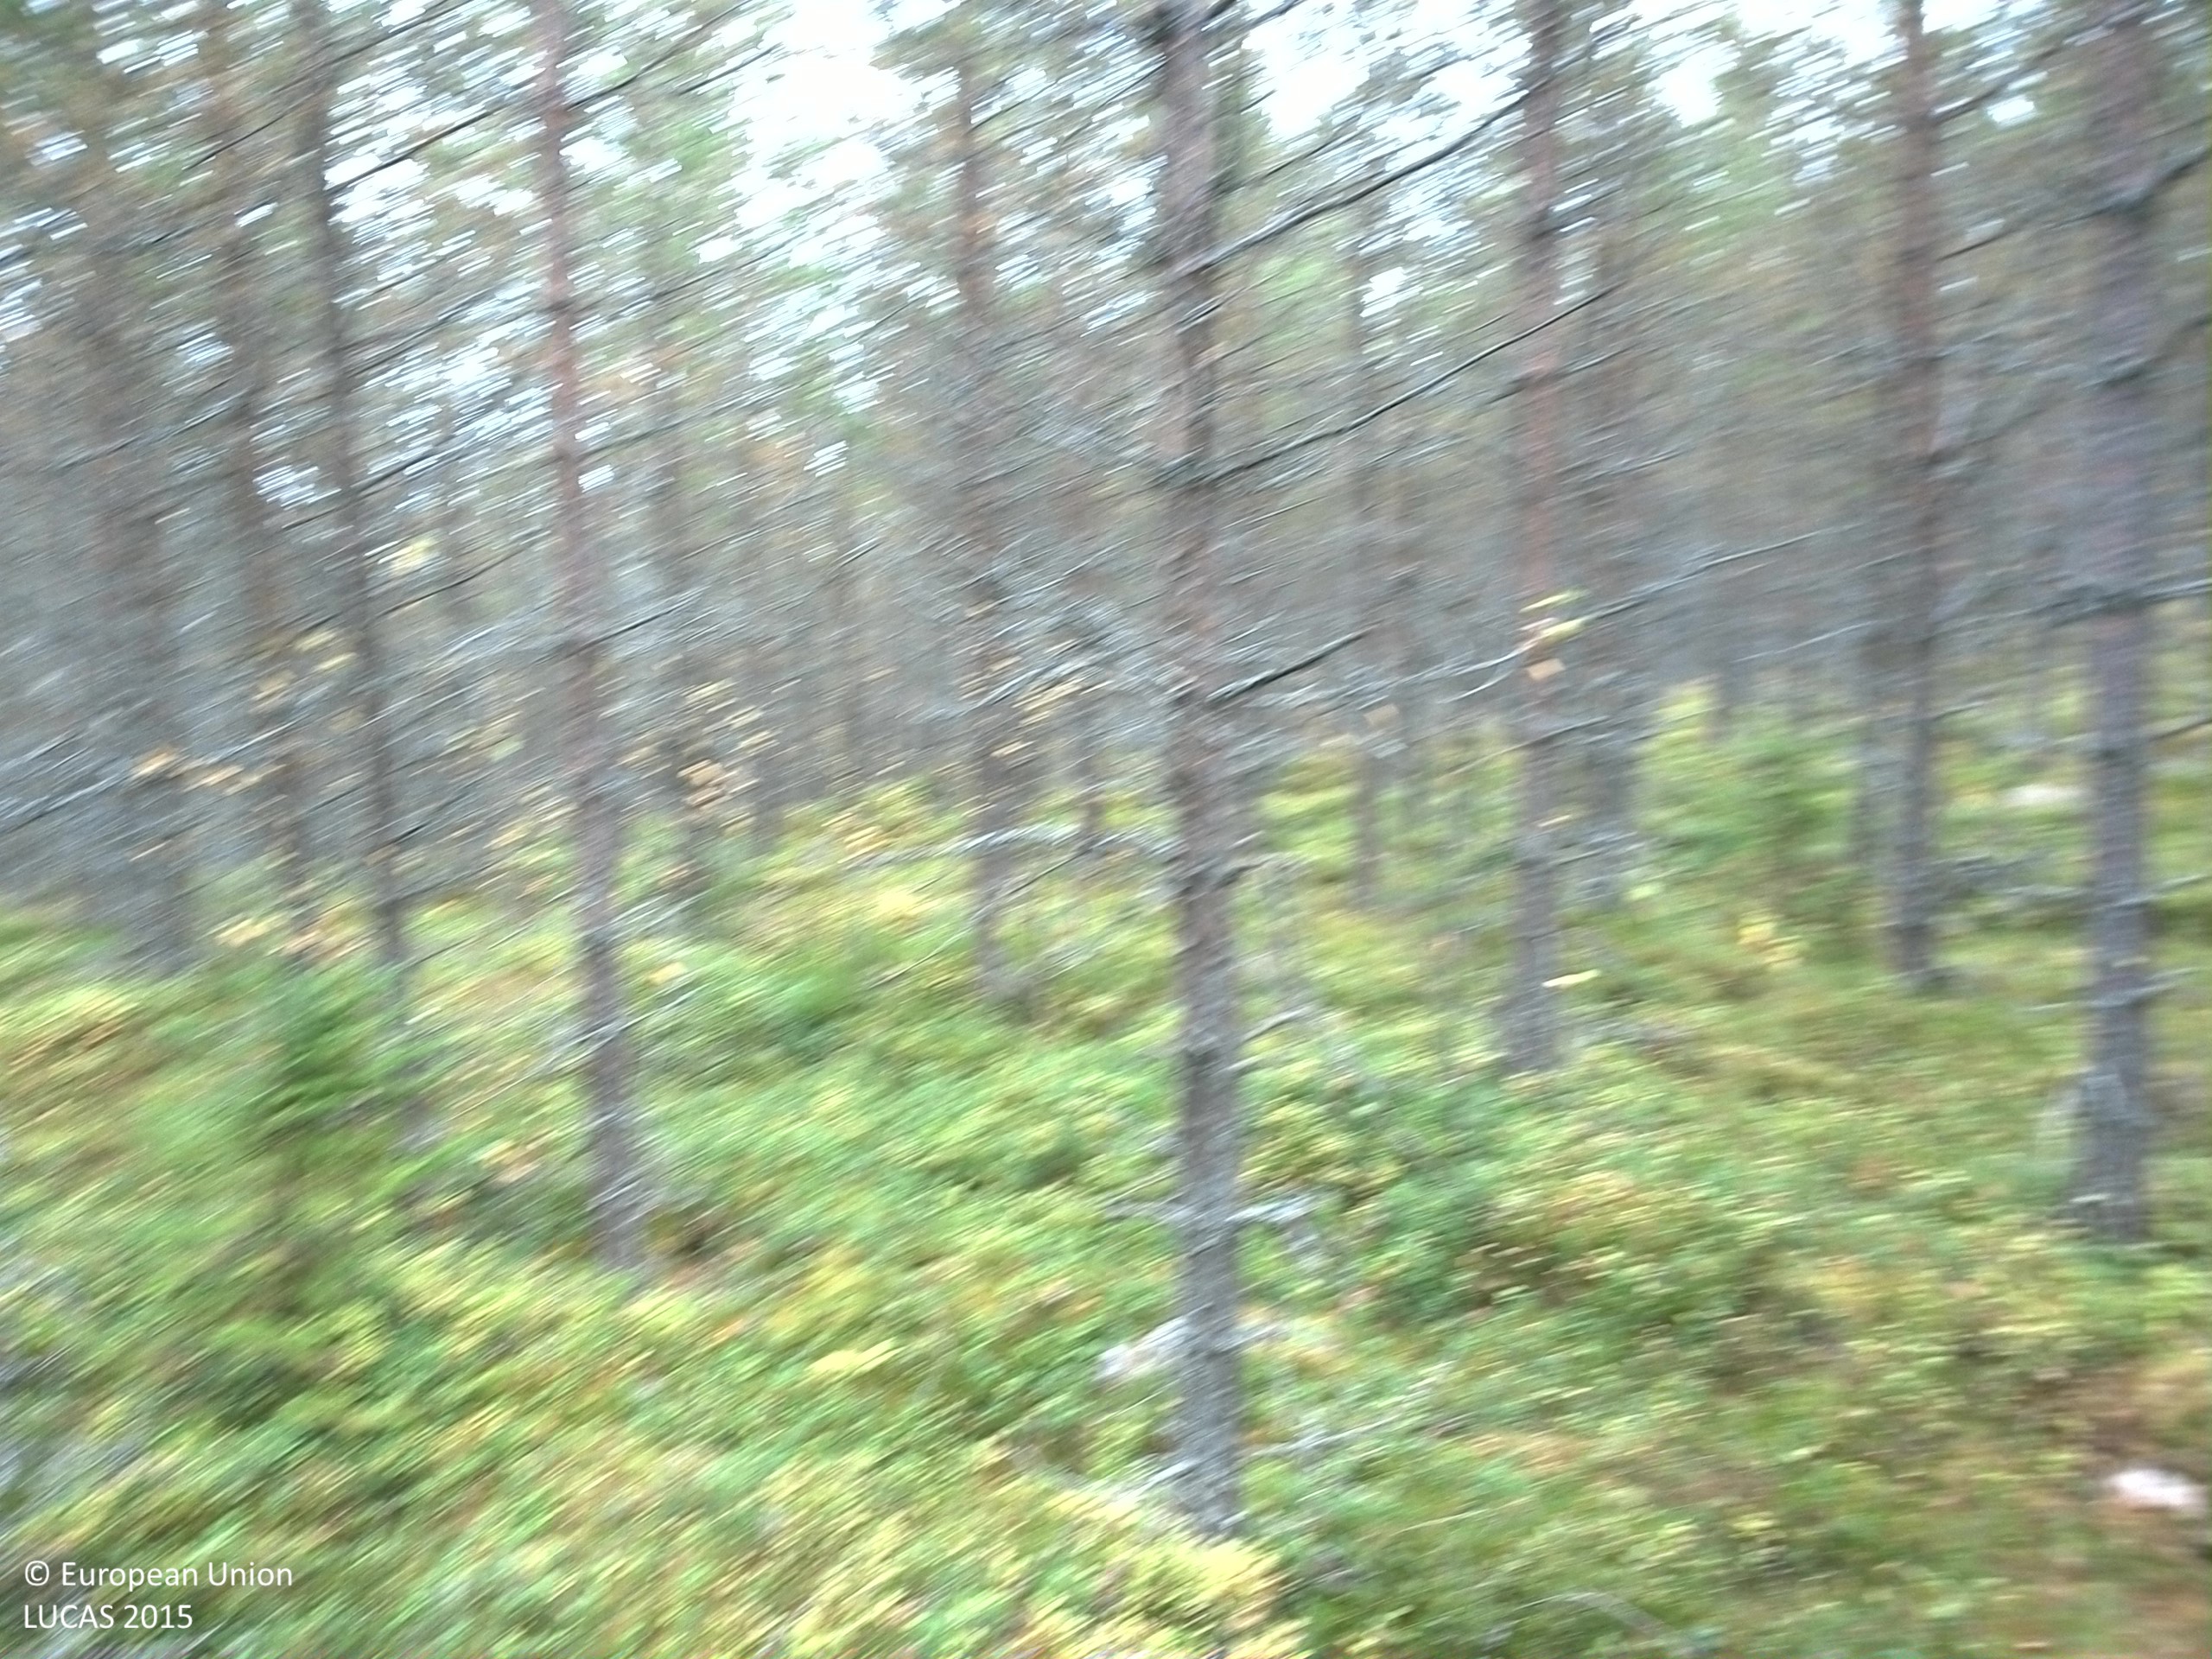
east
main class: Woodland
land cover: Pine dominated coniferous woodland
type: boreal forest
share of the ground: > 75 %
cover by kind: coniferous forest trees 75 %, shrubs 20 %, lichens and mosses 5 %
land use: Forestry
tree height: > 5 m
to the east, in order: Pine dominated coniferous woodland; Other coniferous woodland; Pine dominated coniferous woodland
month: October
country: SE
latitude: 61.4317
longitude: 14.8774
